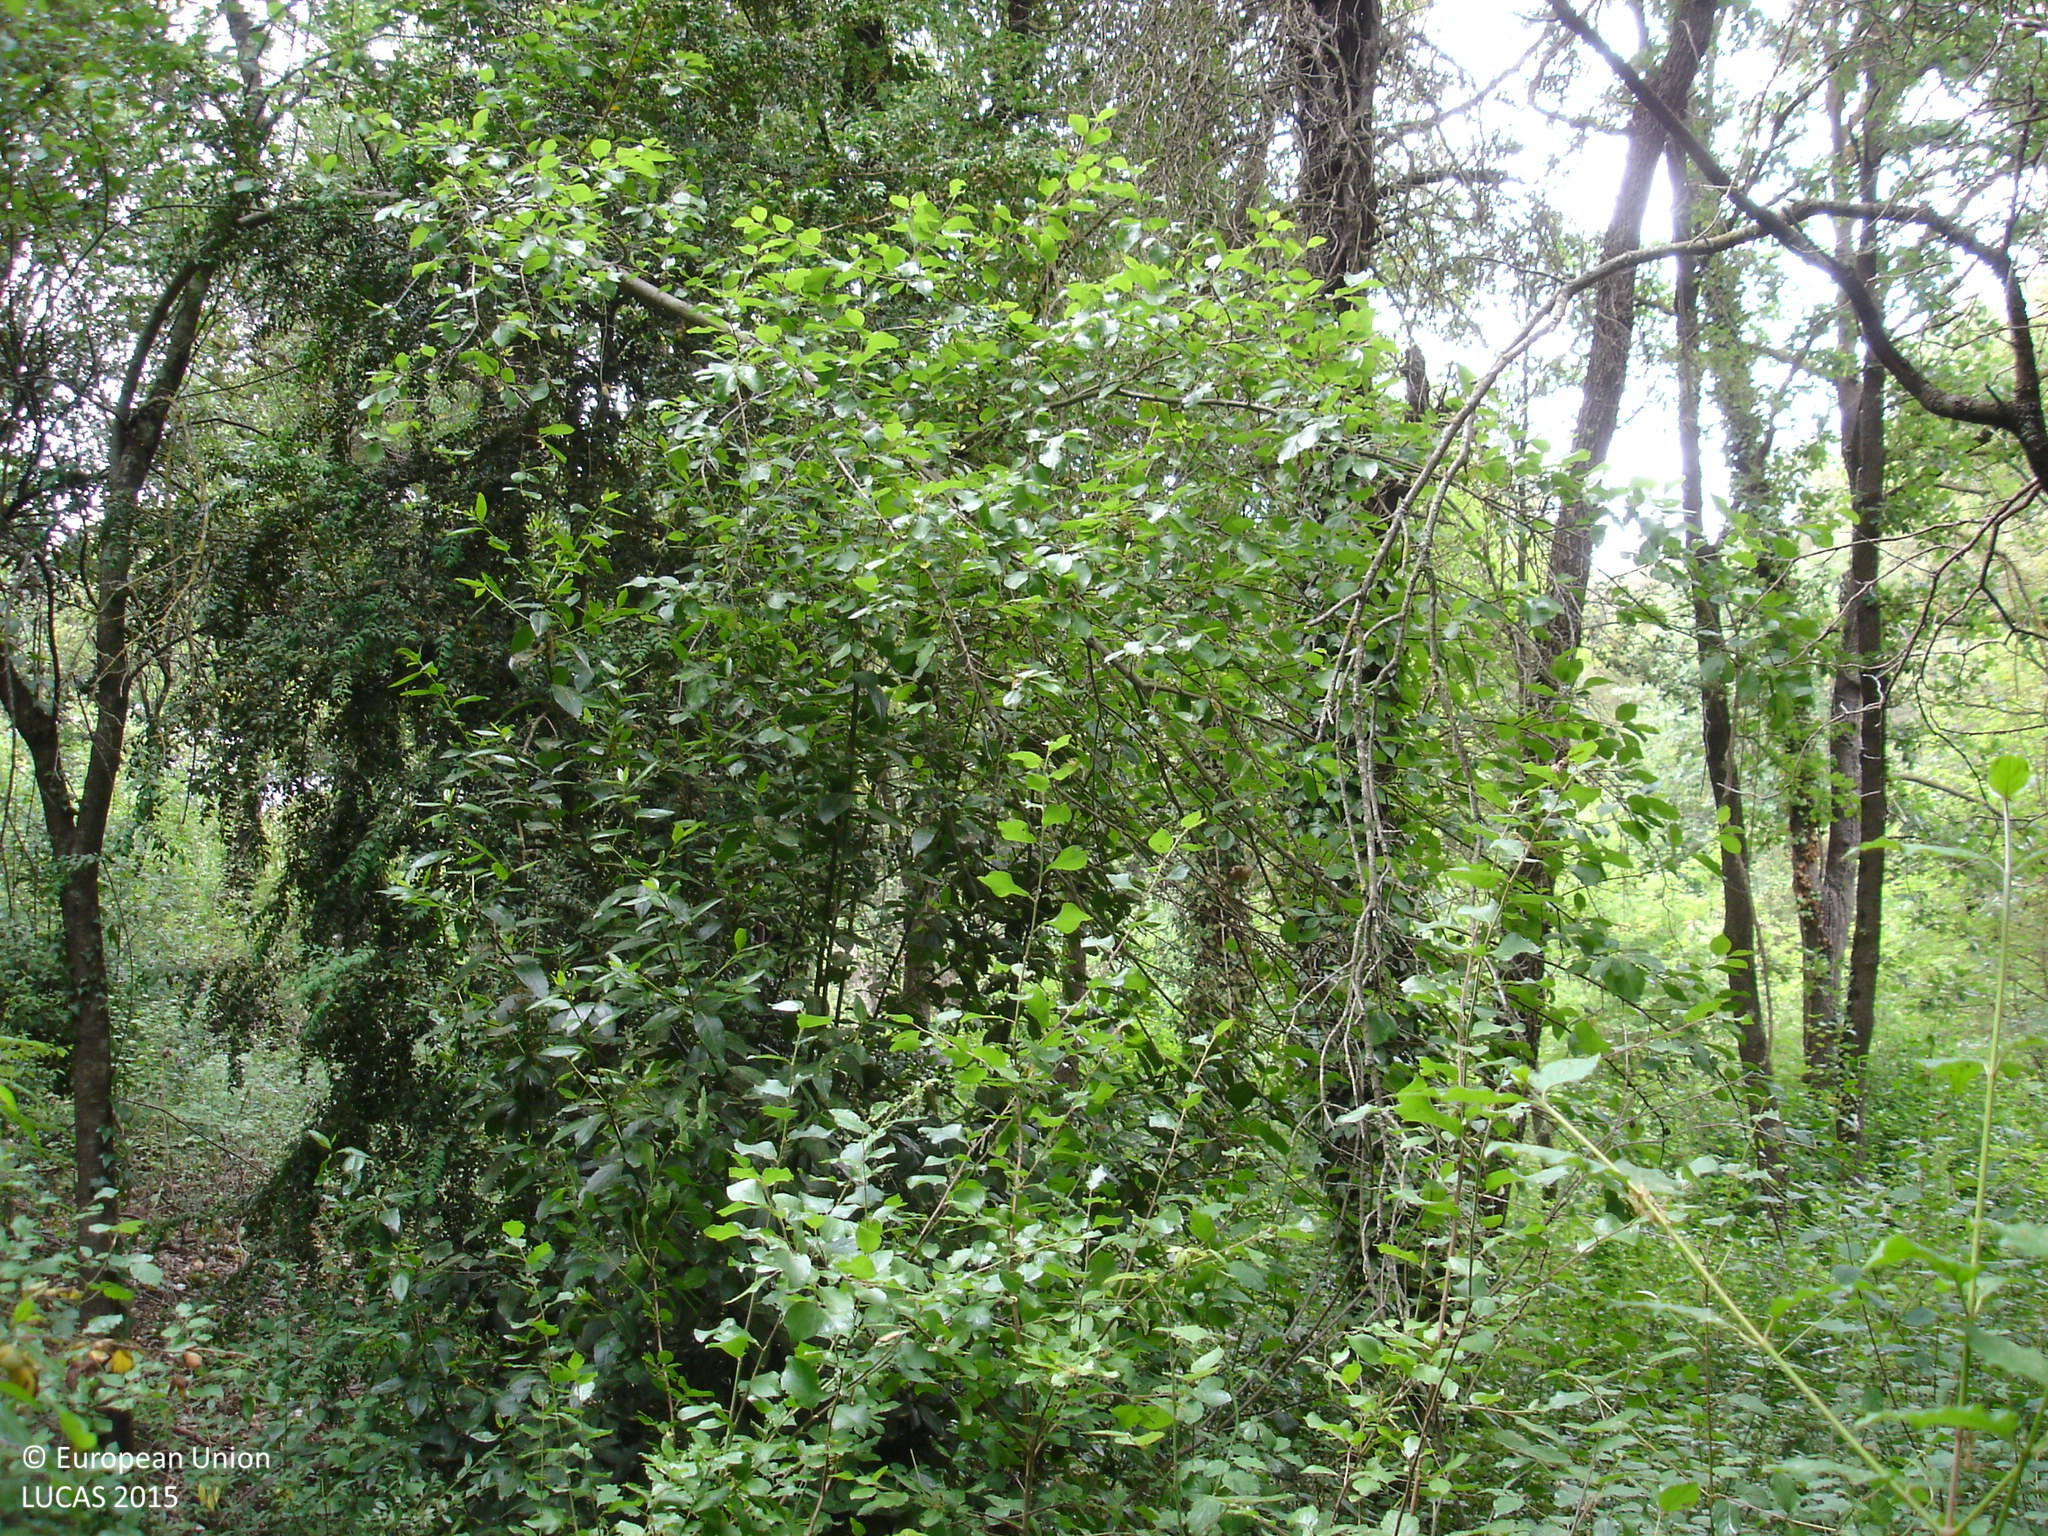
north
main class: Woodland
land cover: Broadleaved woodland
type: thermophilous deciduous forest
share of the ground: > 75 %
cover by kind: broadleaved forest trees 90 %, shrubs 10 %
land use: Forestry
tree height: > 5 m
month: June
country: ES
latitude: 41.7532
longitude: 2.1866
